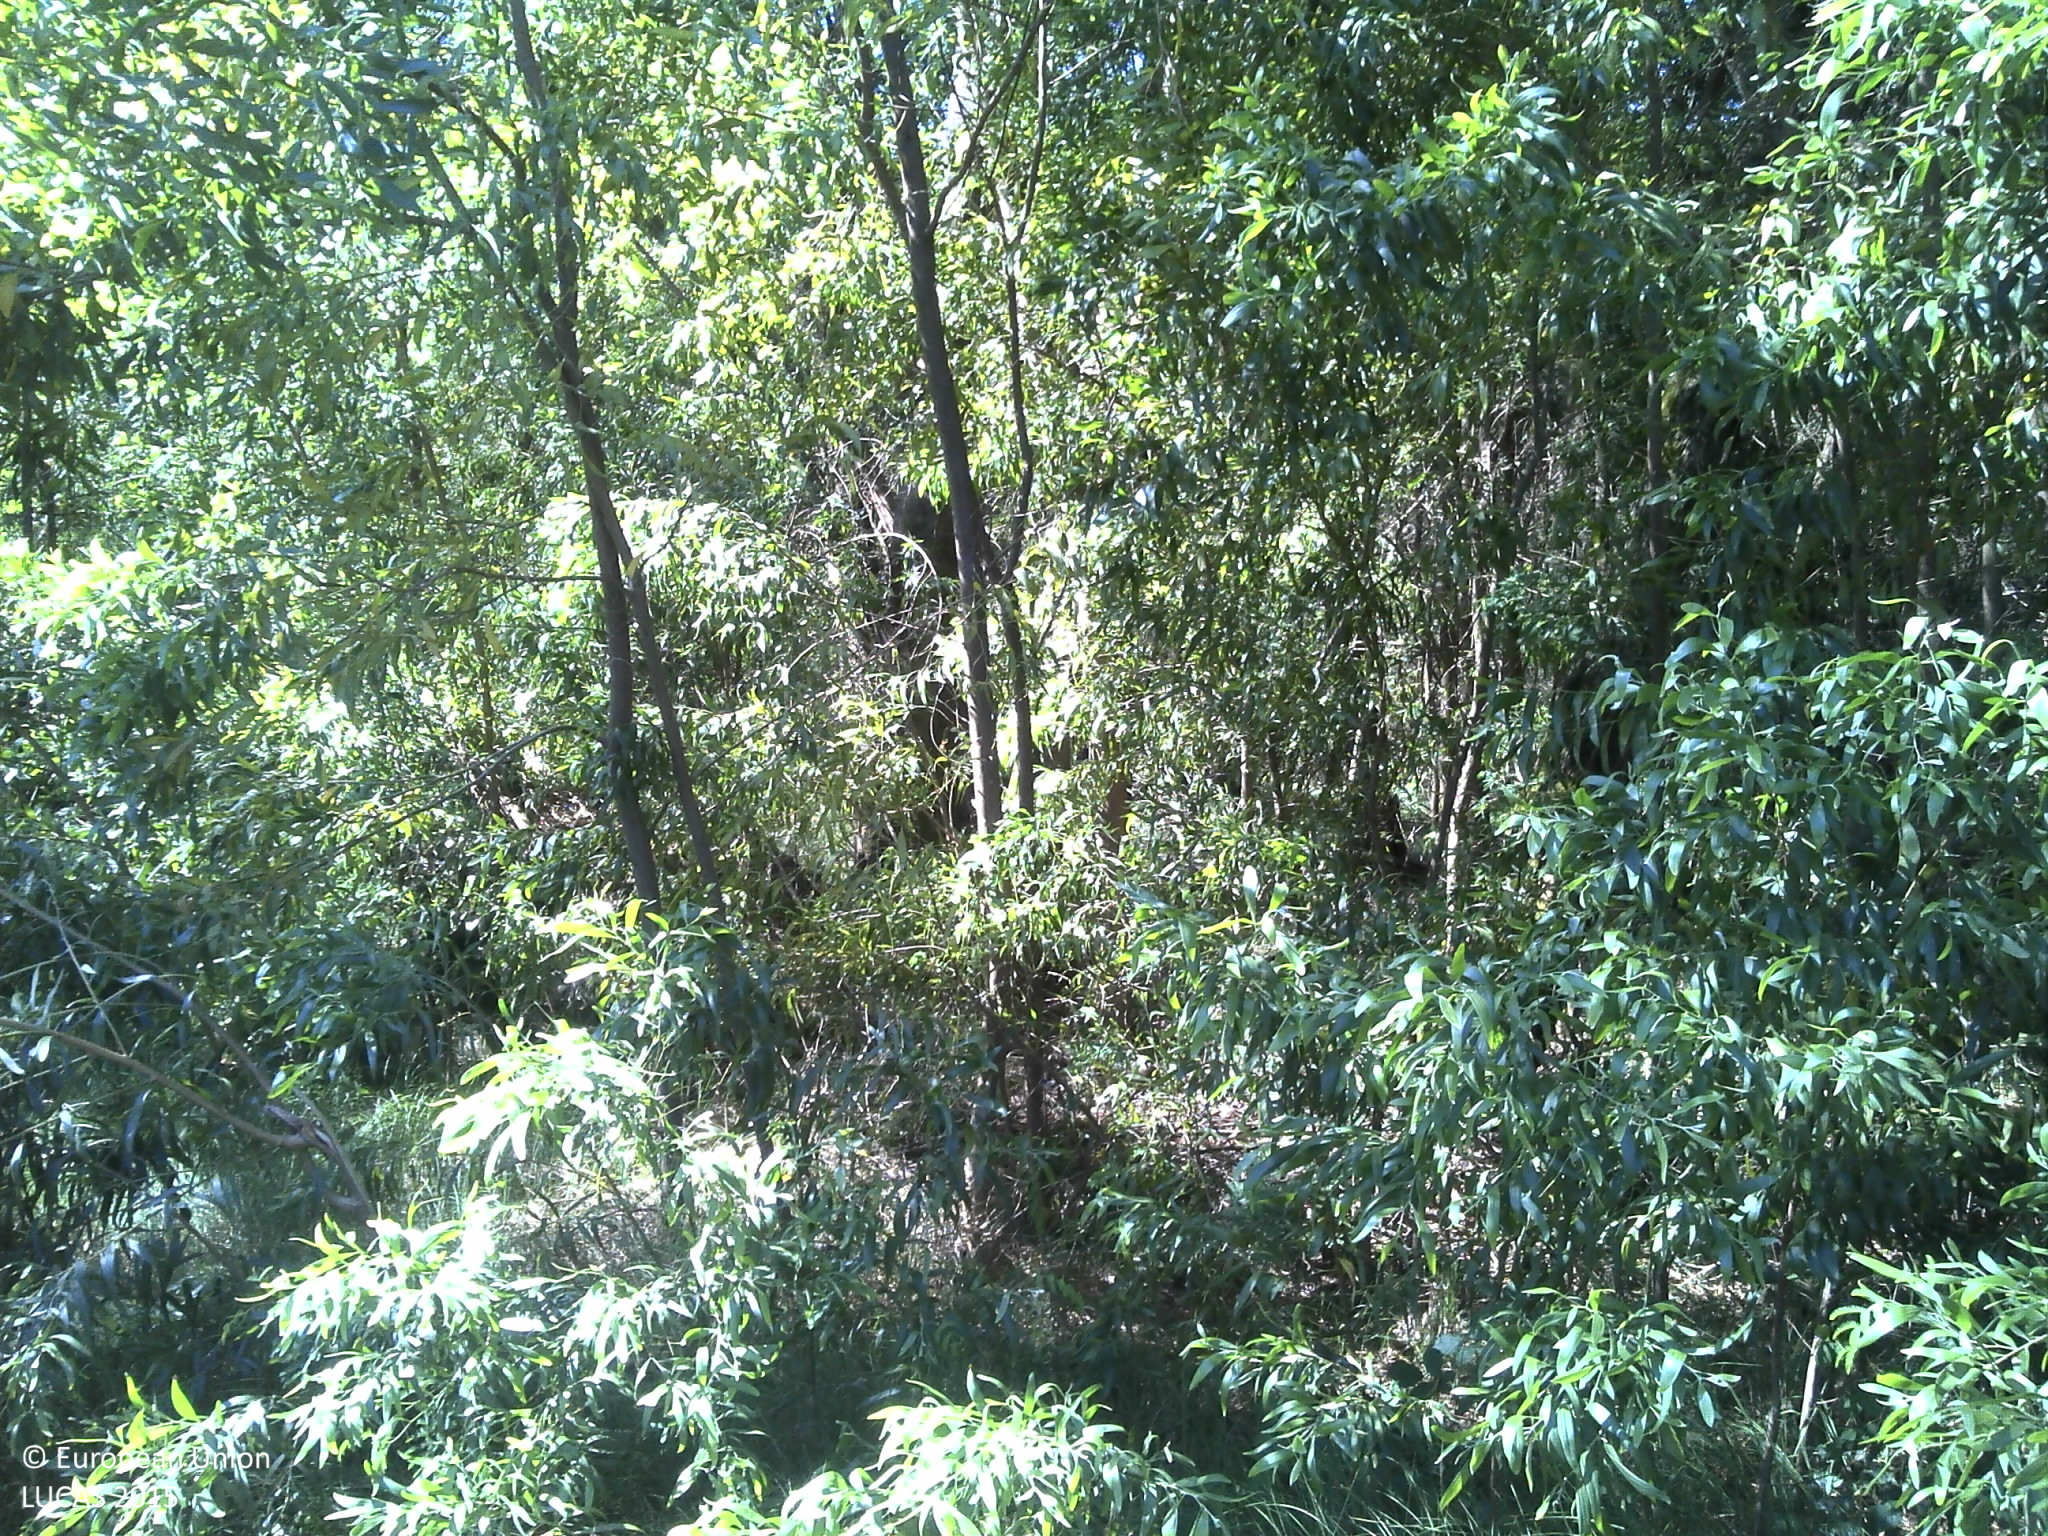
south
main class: Woodland
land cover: Broadleaved woodland
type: exotic forest
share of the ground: 50 - 75 %
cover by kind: broadleaved forest trees 65 %, shrubs 25 %, unconsolidated bare surface 10 %
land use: Forestry
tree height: > 5 m
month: May
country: PT
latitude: 40.4823
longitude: -8.7239
